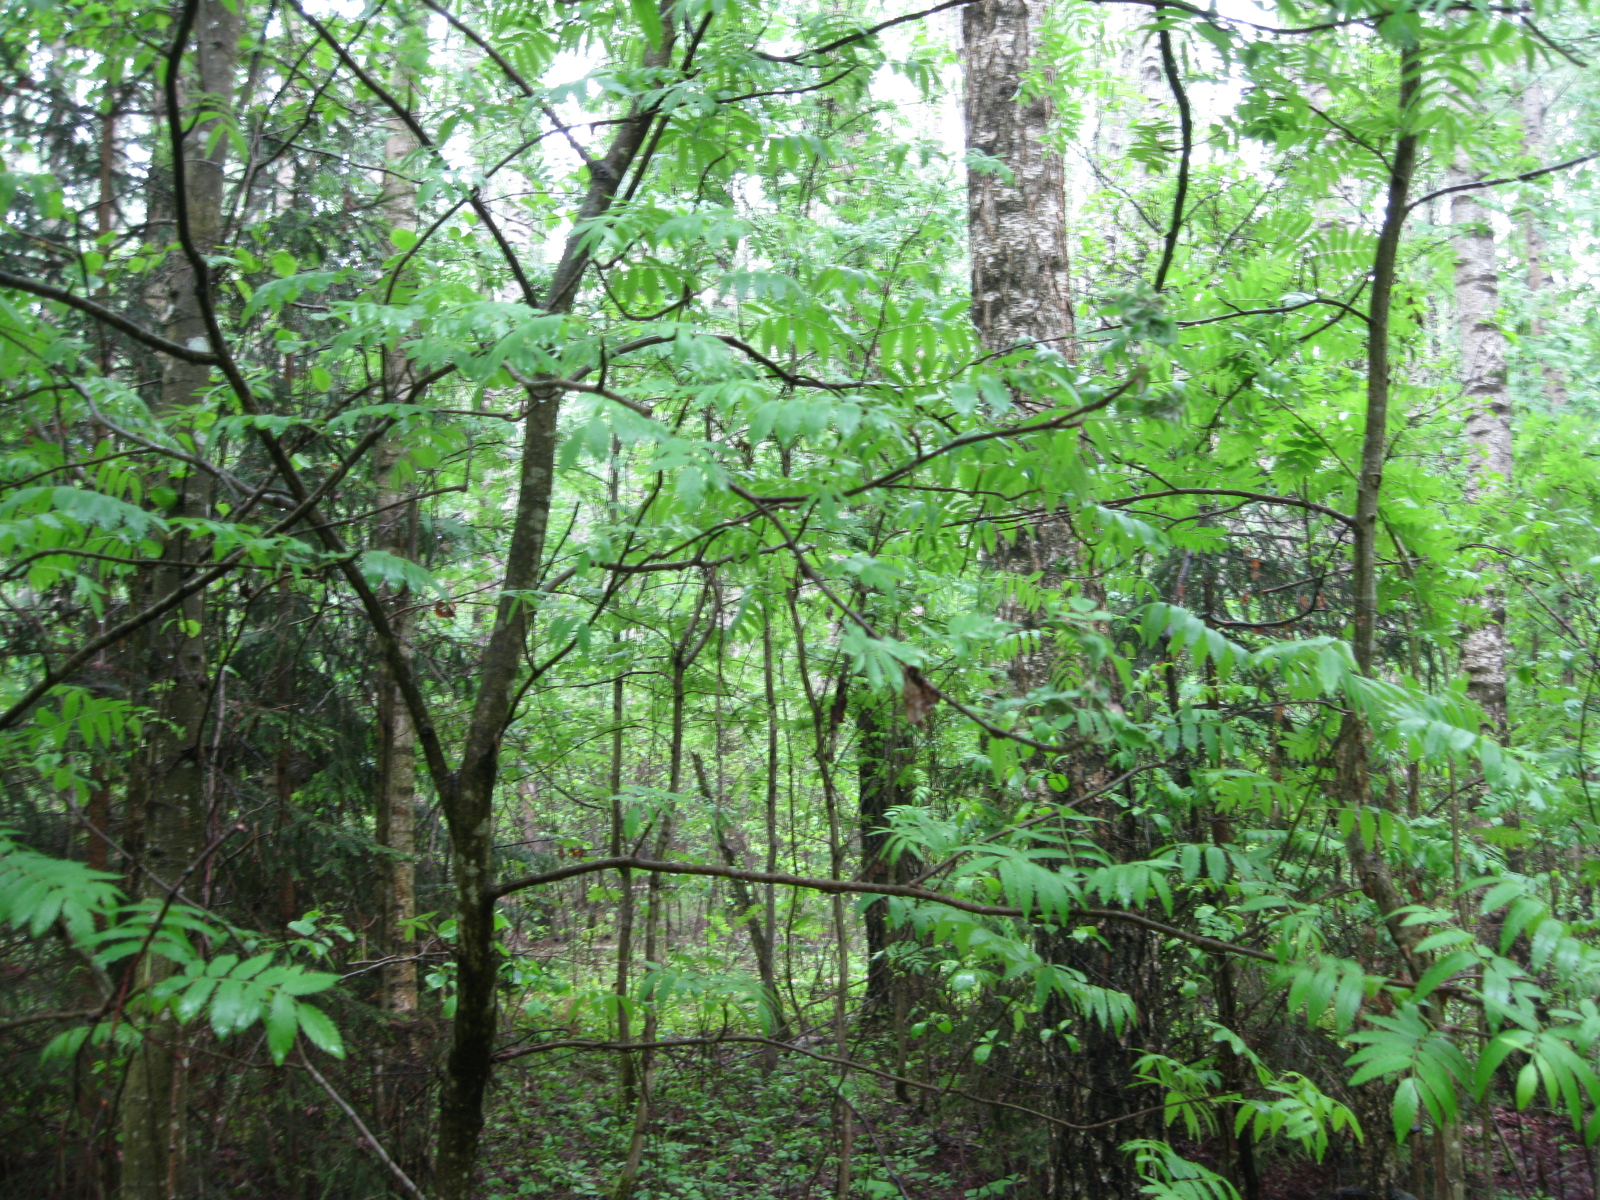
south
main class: Woodland
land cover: Broadleaved woodland
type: non-riverine alder, birch or aspen forest
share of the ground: > 75 %
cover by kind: broadleaved forest trees 80 %, coniferous forest trees 10 %, shrubs 5 %, herbaceous plants 5 %
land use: Forestry
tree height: > 5 m
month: May
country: LT
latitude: 55.8850
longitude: 24.3724
